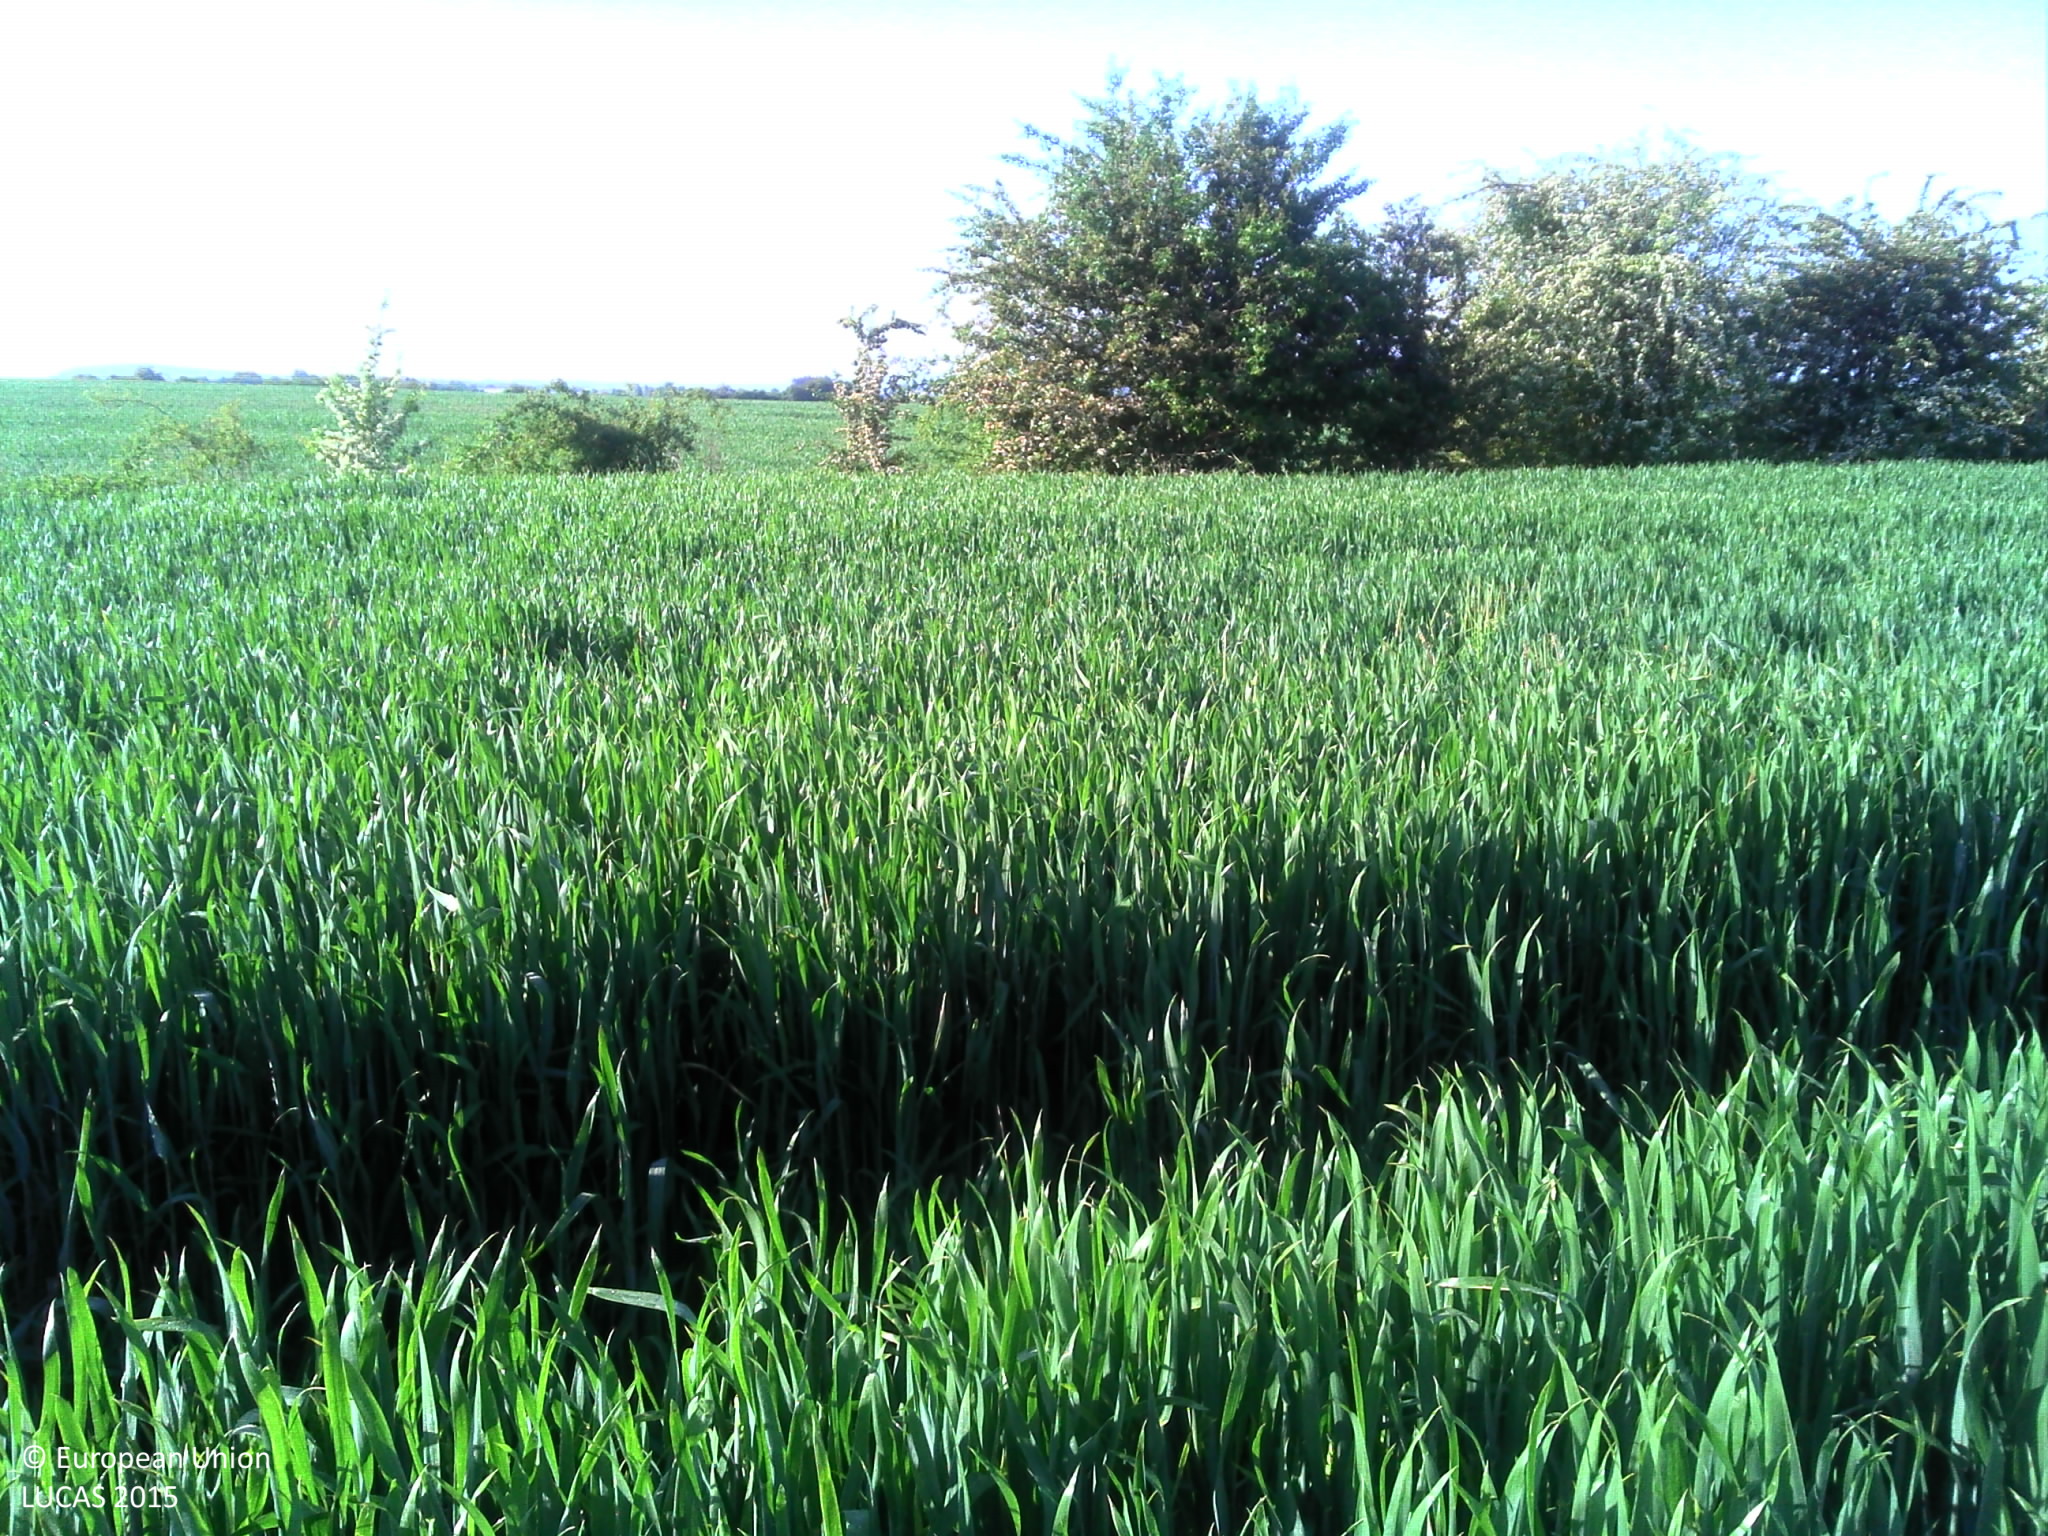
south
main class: Cropland
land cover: Common wheat
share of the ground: > 75 %
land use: Agriculture (excluding fallow land and kitchen gardens)
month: May
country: LU
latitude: 49.4946
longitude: 6.3134
